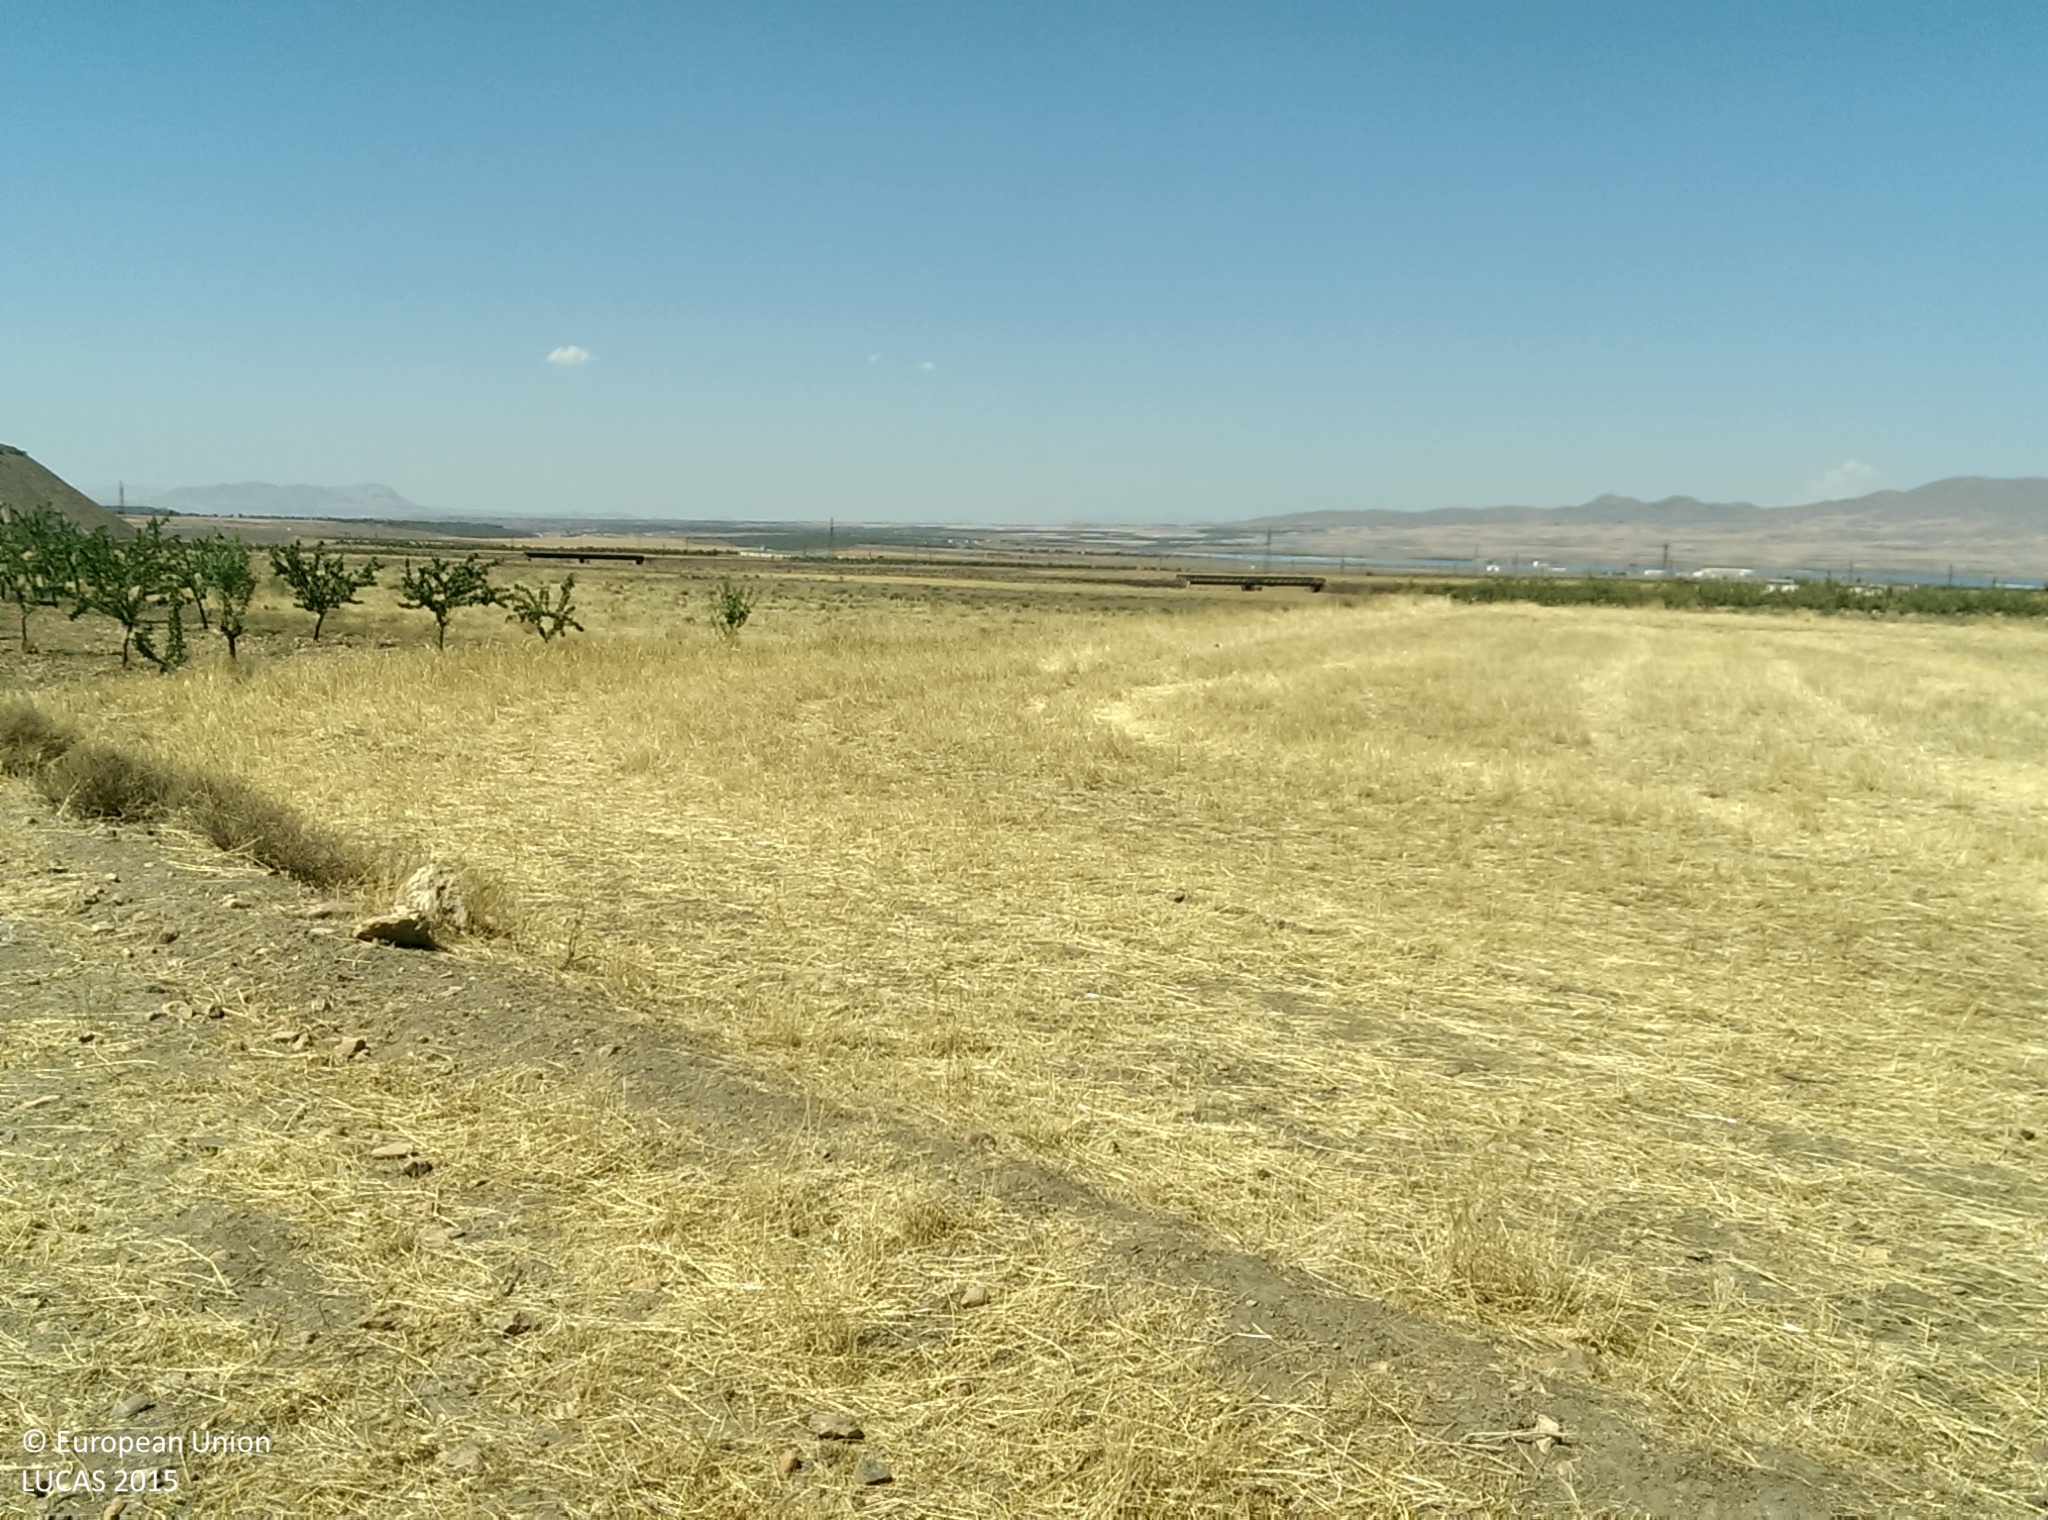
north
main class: Cropland
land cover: Barley
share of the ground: < 10 %
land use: Agriculture (excluding fallow land and kitchen gardens)
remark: Harvested field
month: July
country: ES
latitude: 37.1877
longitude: -3.0858
